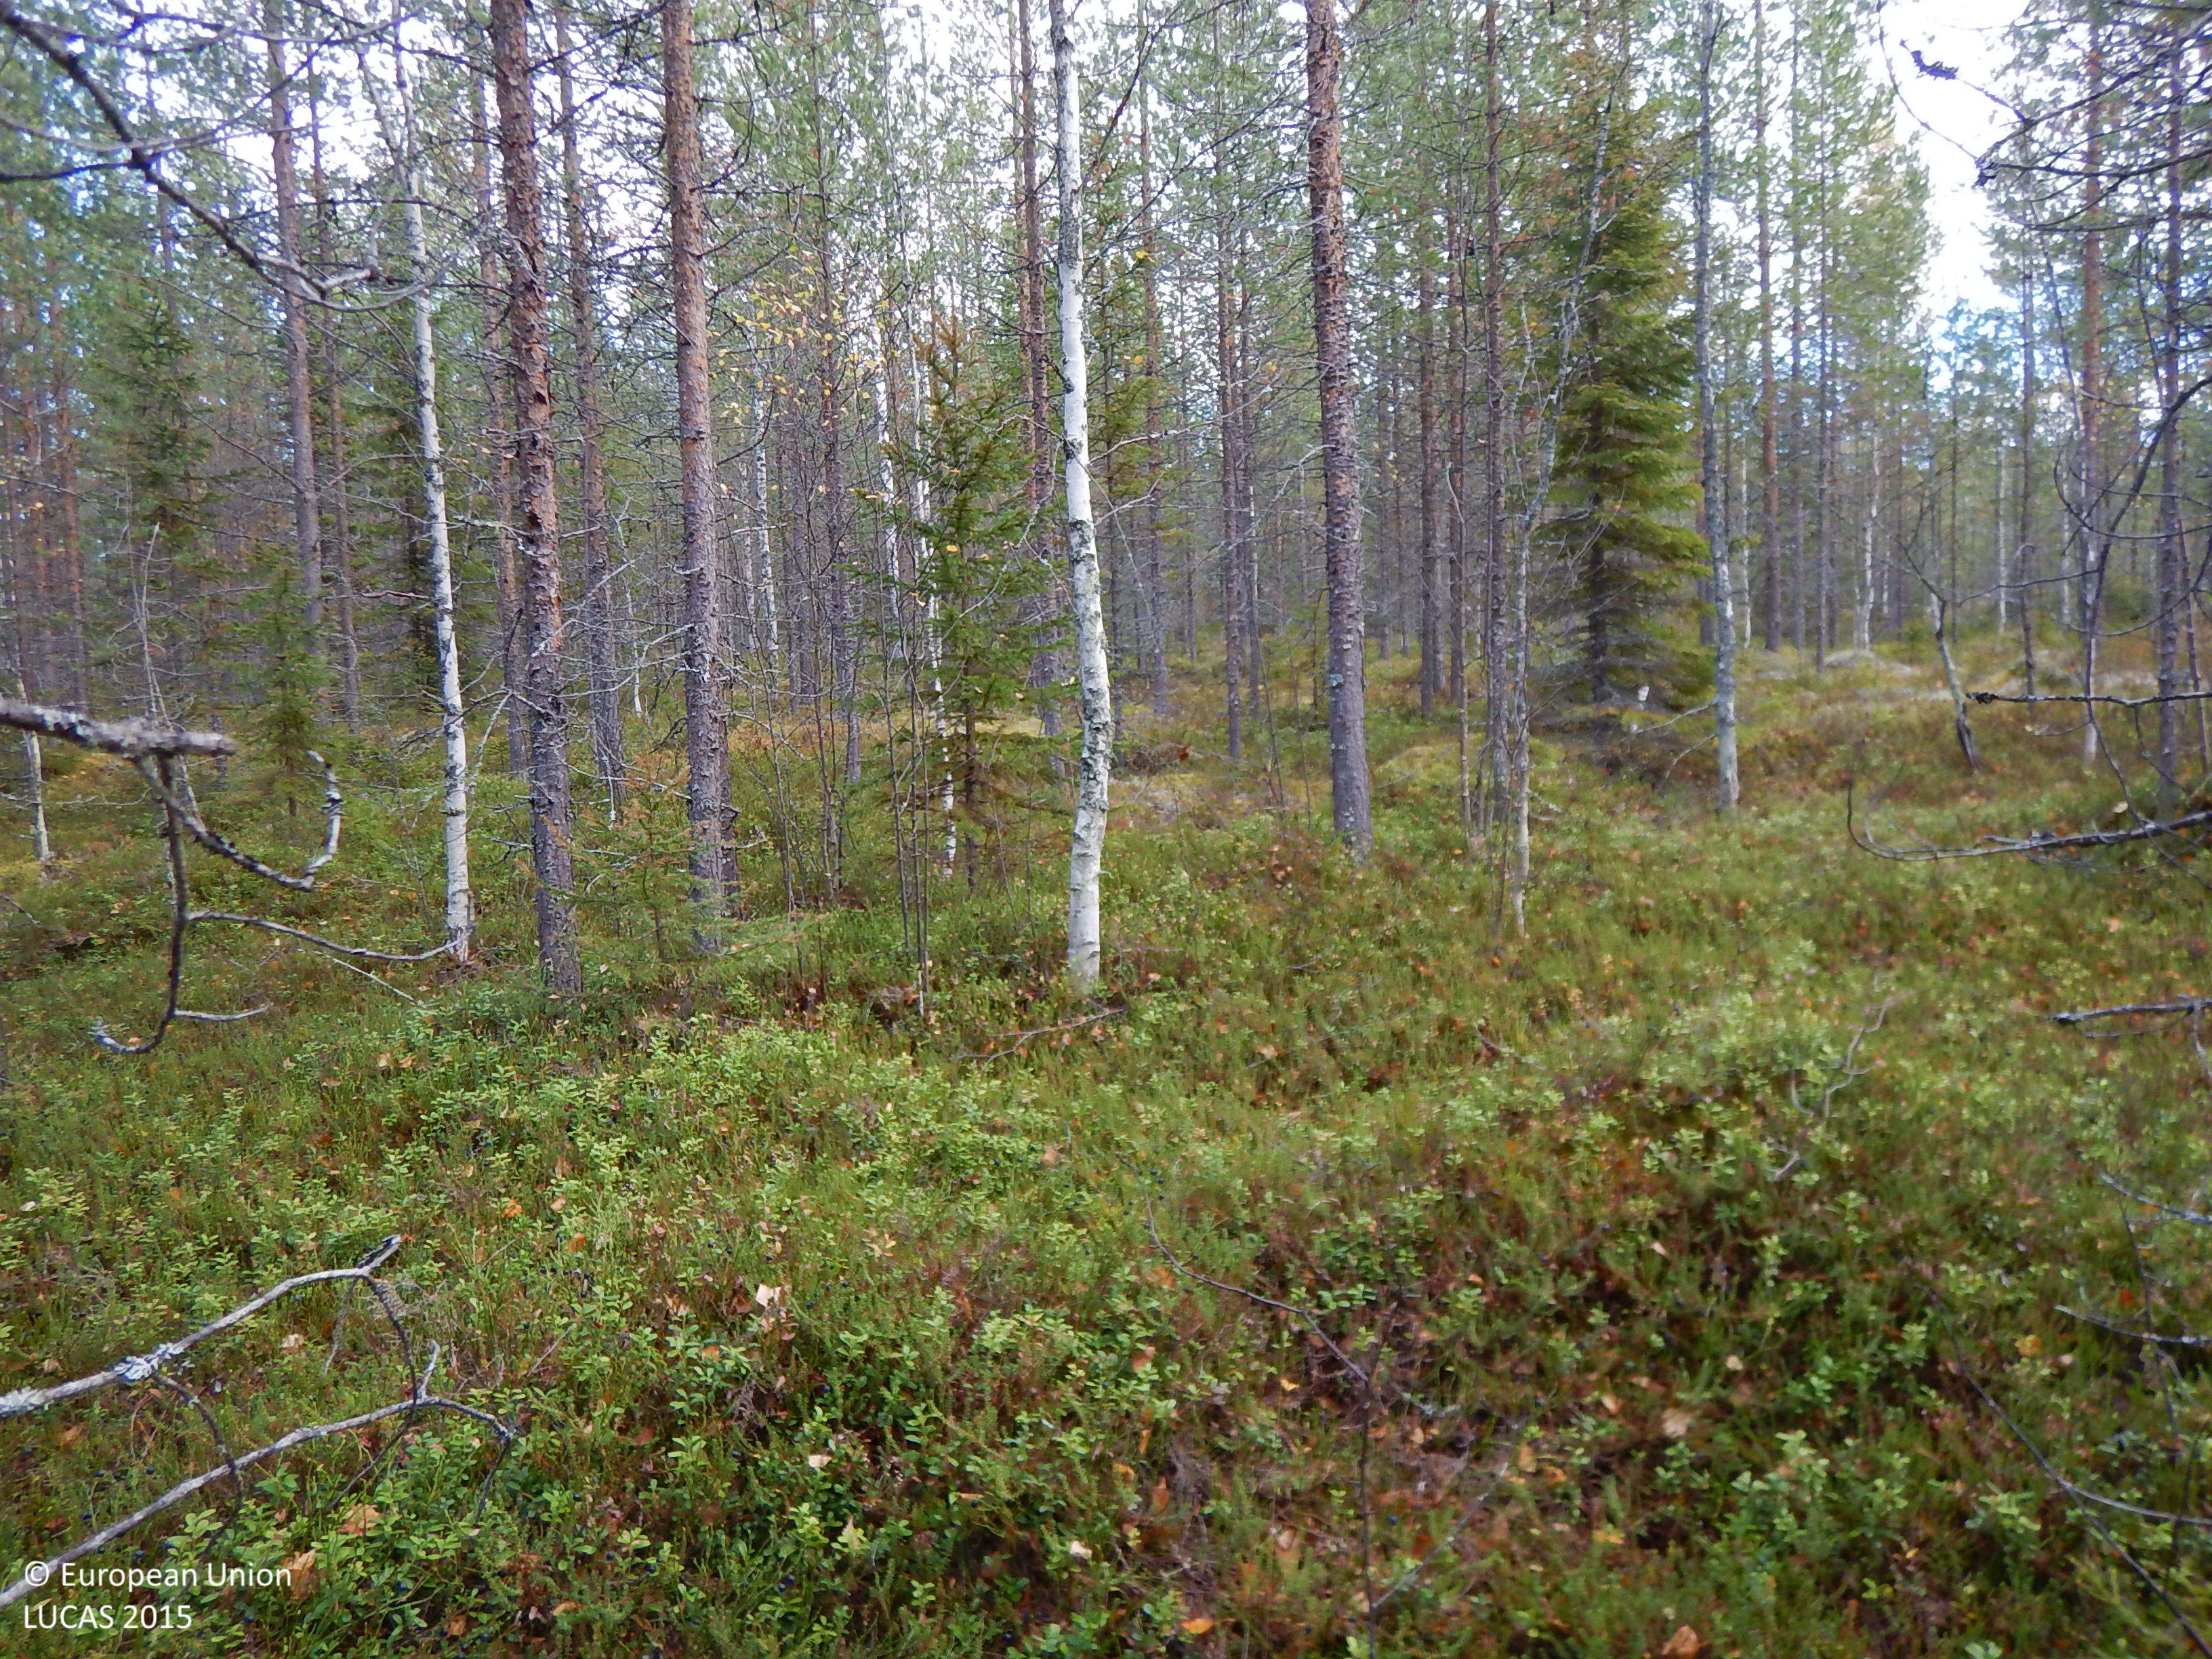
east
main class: Woodland
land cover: Pine dominated mixed woodland
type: boreal forest
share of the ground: 50 - 75 %
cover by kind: coniferous forest trees 45 %, broadleaved forest trees 20 %, shrubs 15 %, herbaceous plants 10 %, lichens and mosses 10 %
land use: Forestry
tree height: > 5 m
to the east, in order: Pine dominated mixed woodland; Pine dominated coniferous woodland
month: October
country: SE
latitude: 65.0918
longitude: 21.0191
